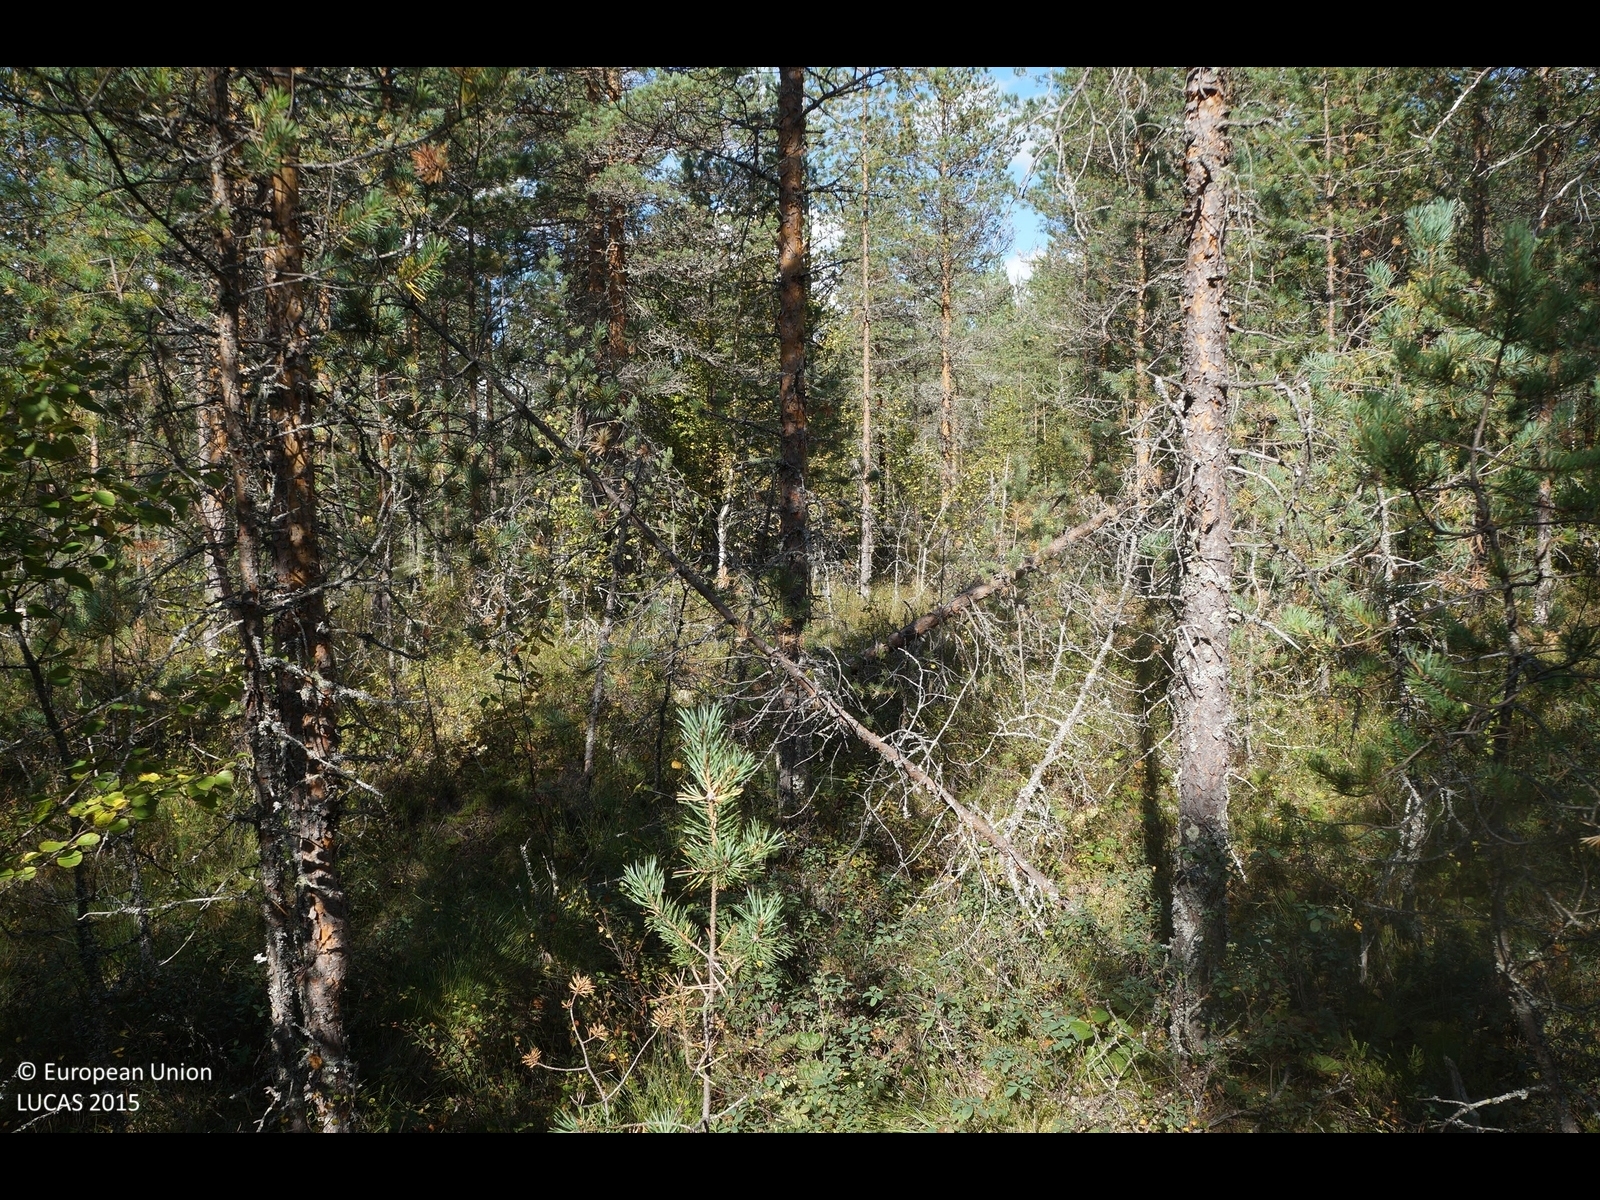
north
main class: Woodland
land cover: Pine dominated coniferous woodland
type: boreal forest
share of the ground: 50 - 75 %
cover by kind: coniferous forest trees 55 %, shrubs 30 %, lichens and mosses 10 %, herbaceous plants 5 %
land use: Forestry
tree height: > 5 m
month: September
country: FI
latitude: 63.9944
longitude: 24.4025
